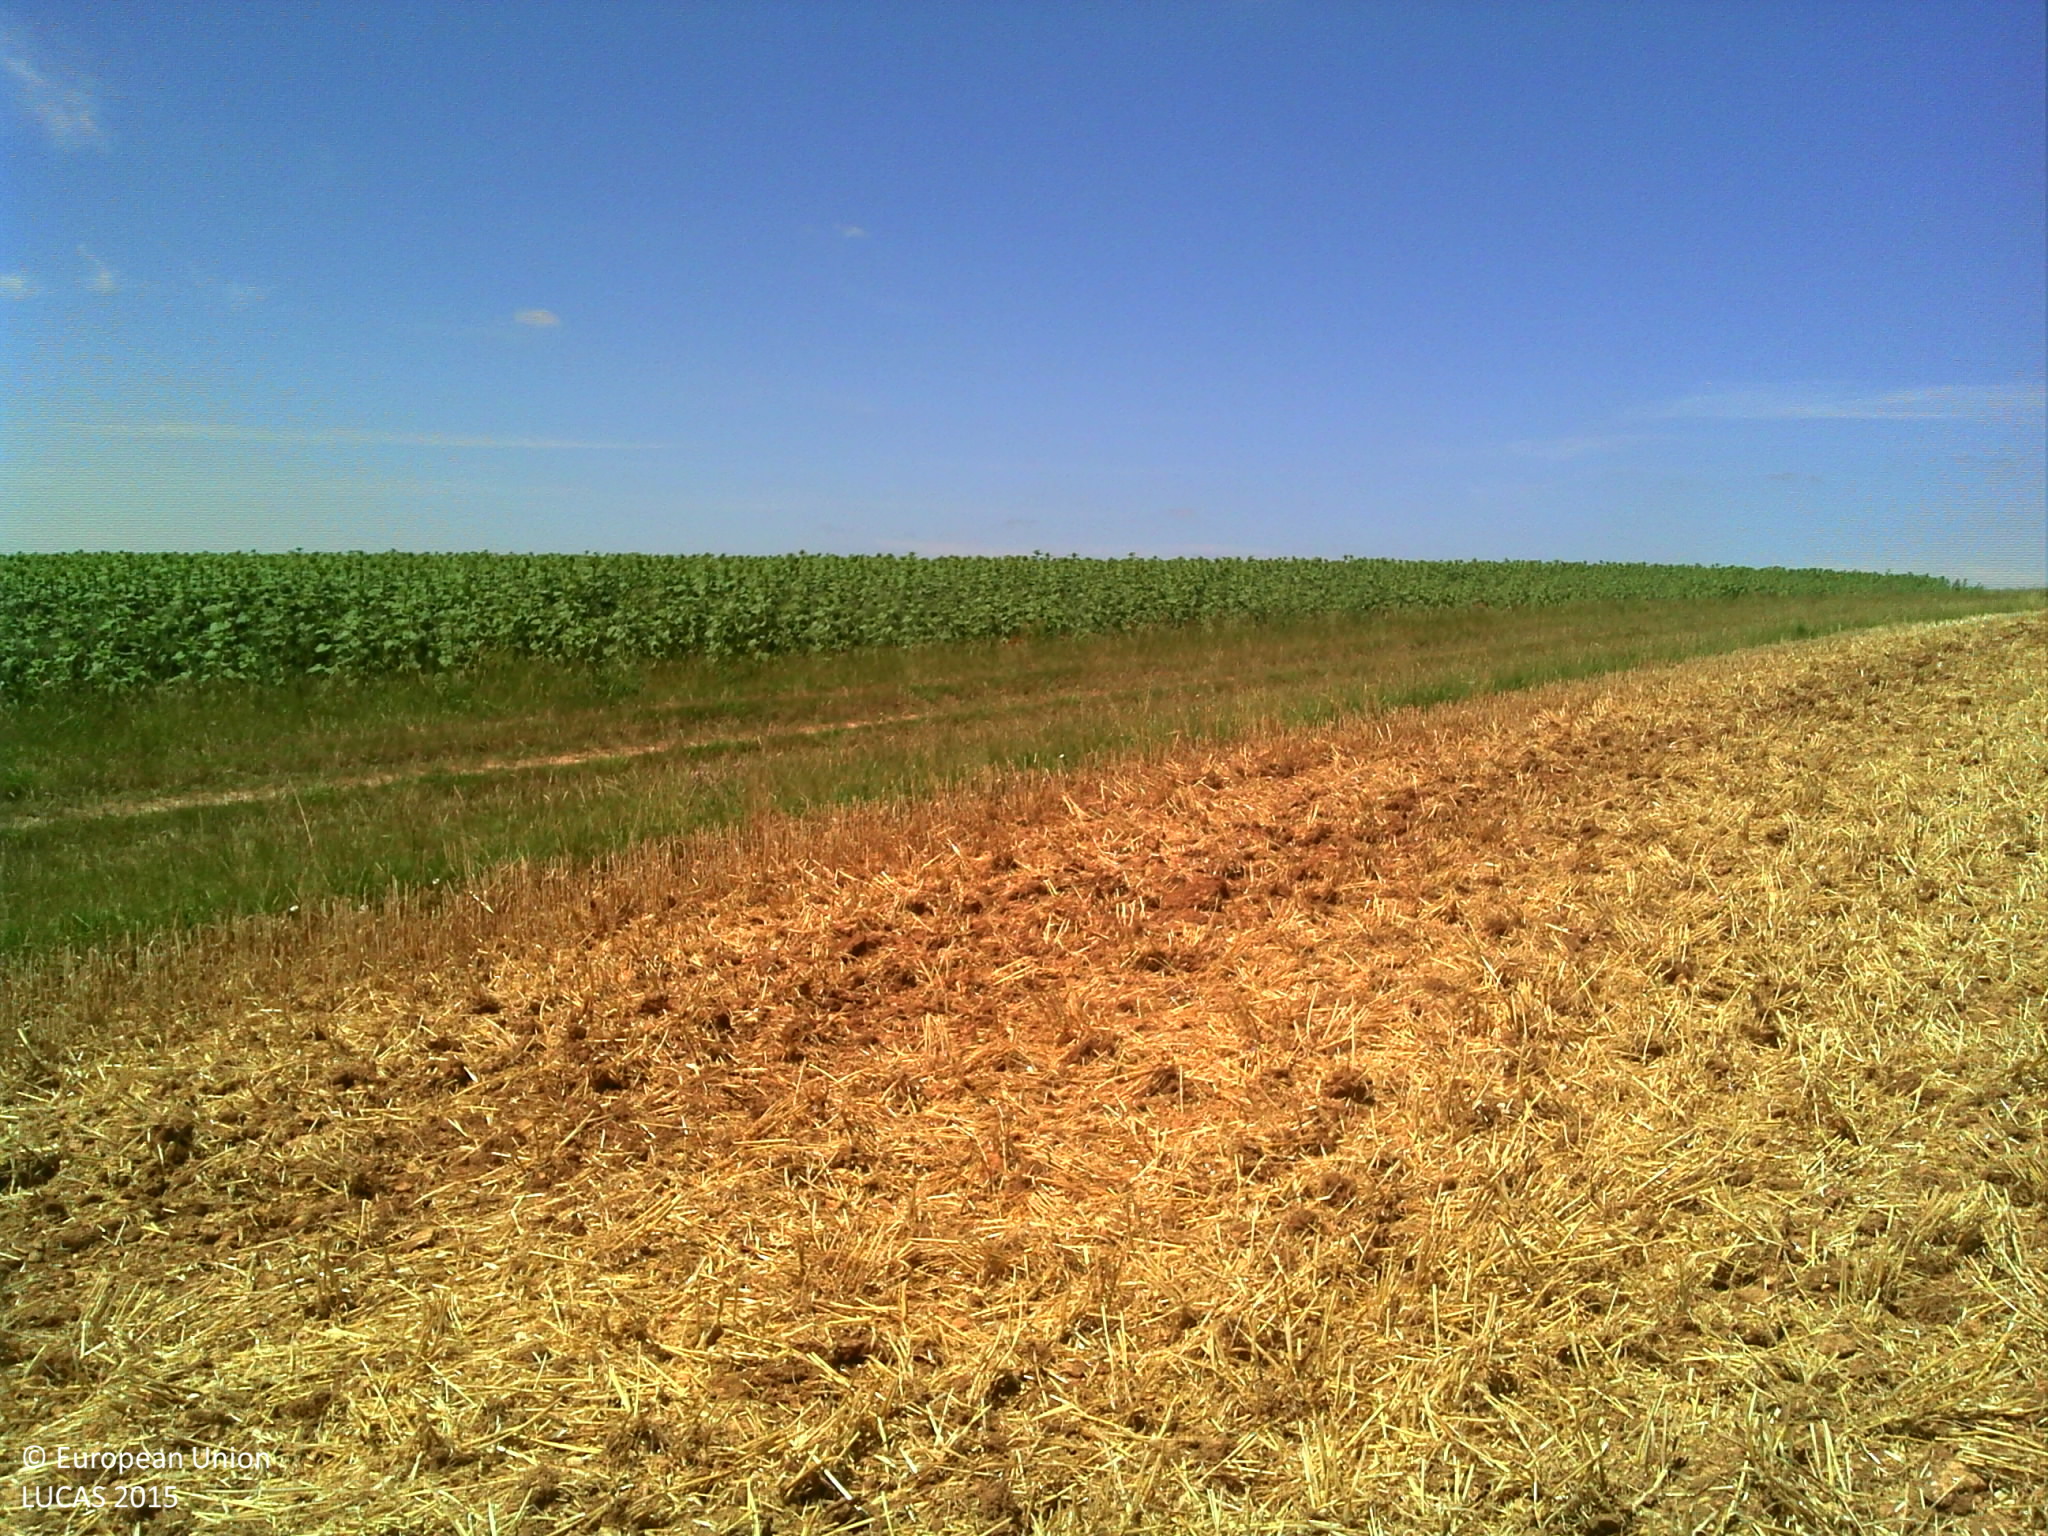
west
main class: Cropland
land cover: Barley
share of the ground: > 75 %
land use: Agriculture (excluding fallow land and kitchen gardens)
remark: Harvested field
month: June
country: FR
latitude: 47.1986
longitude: 2.6146
